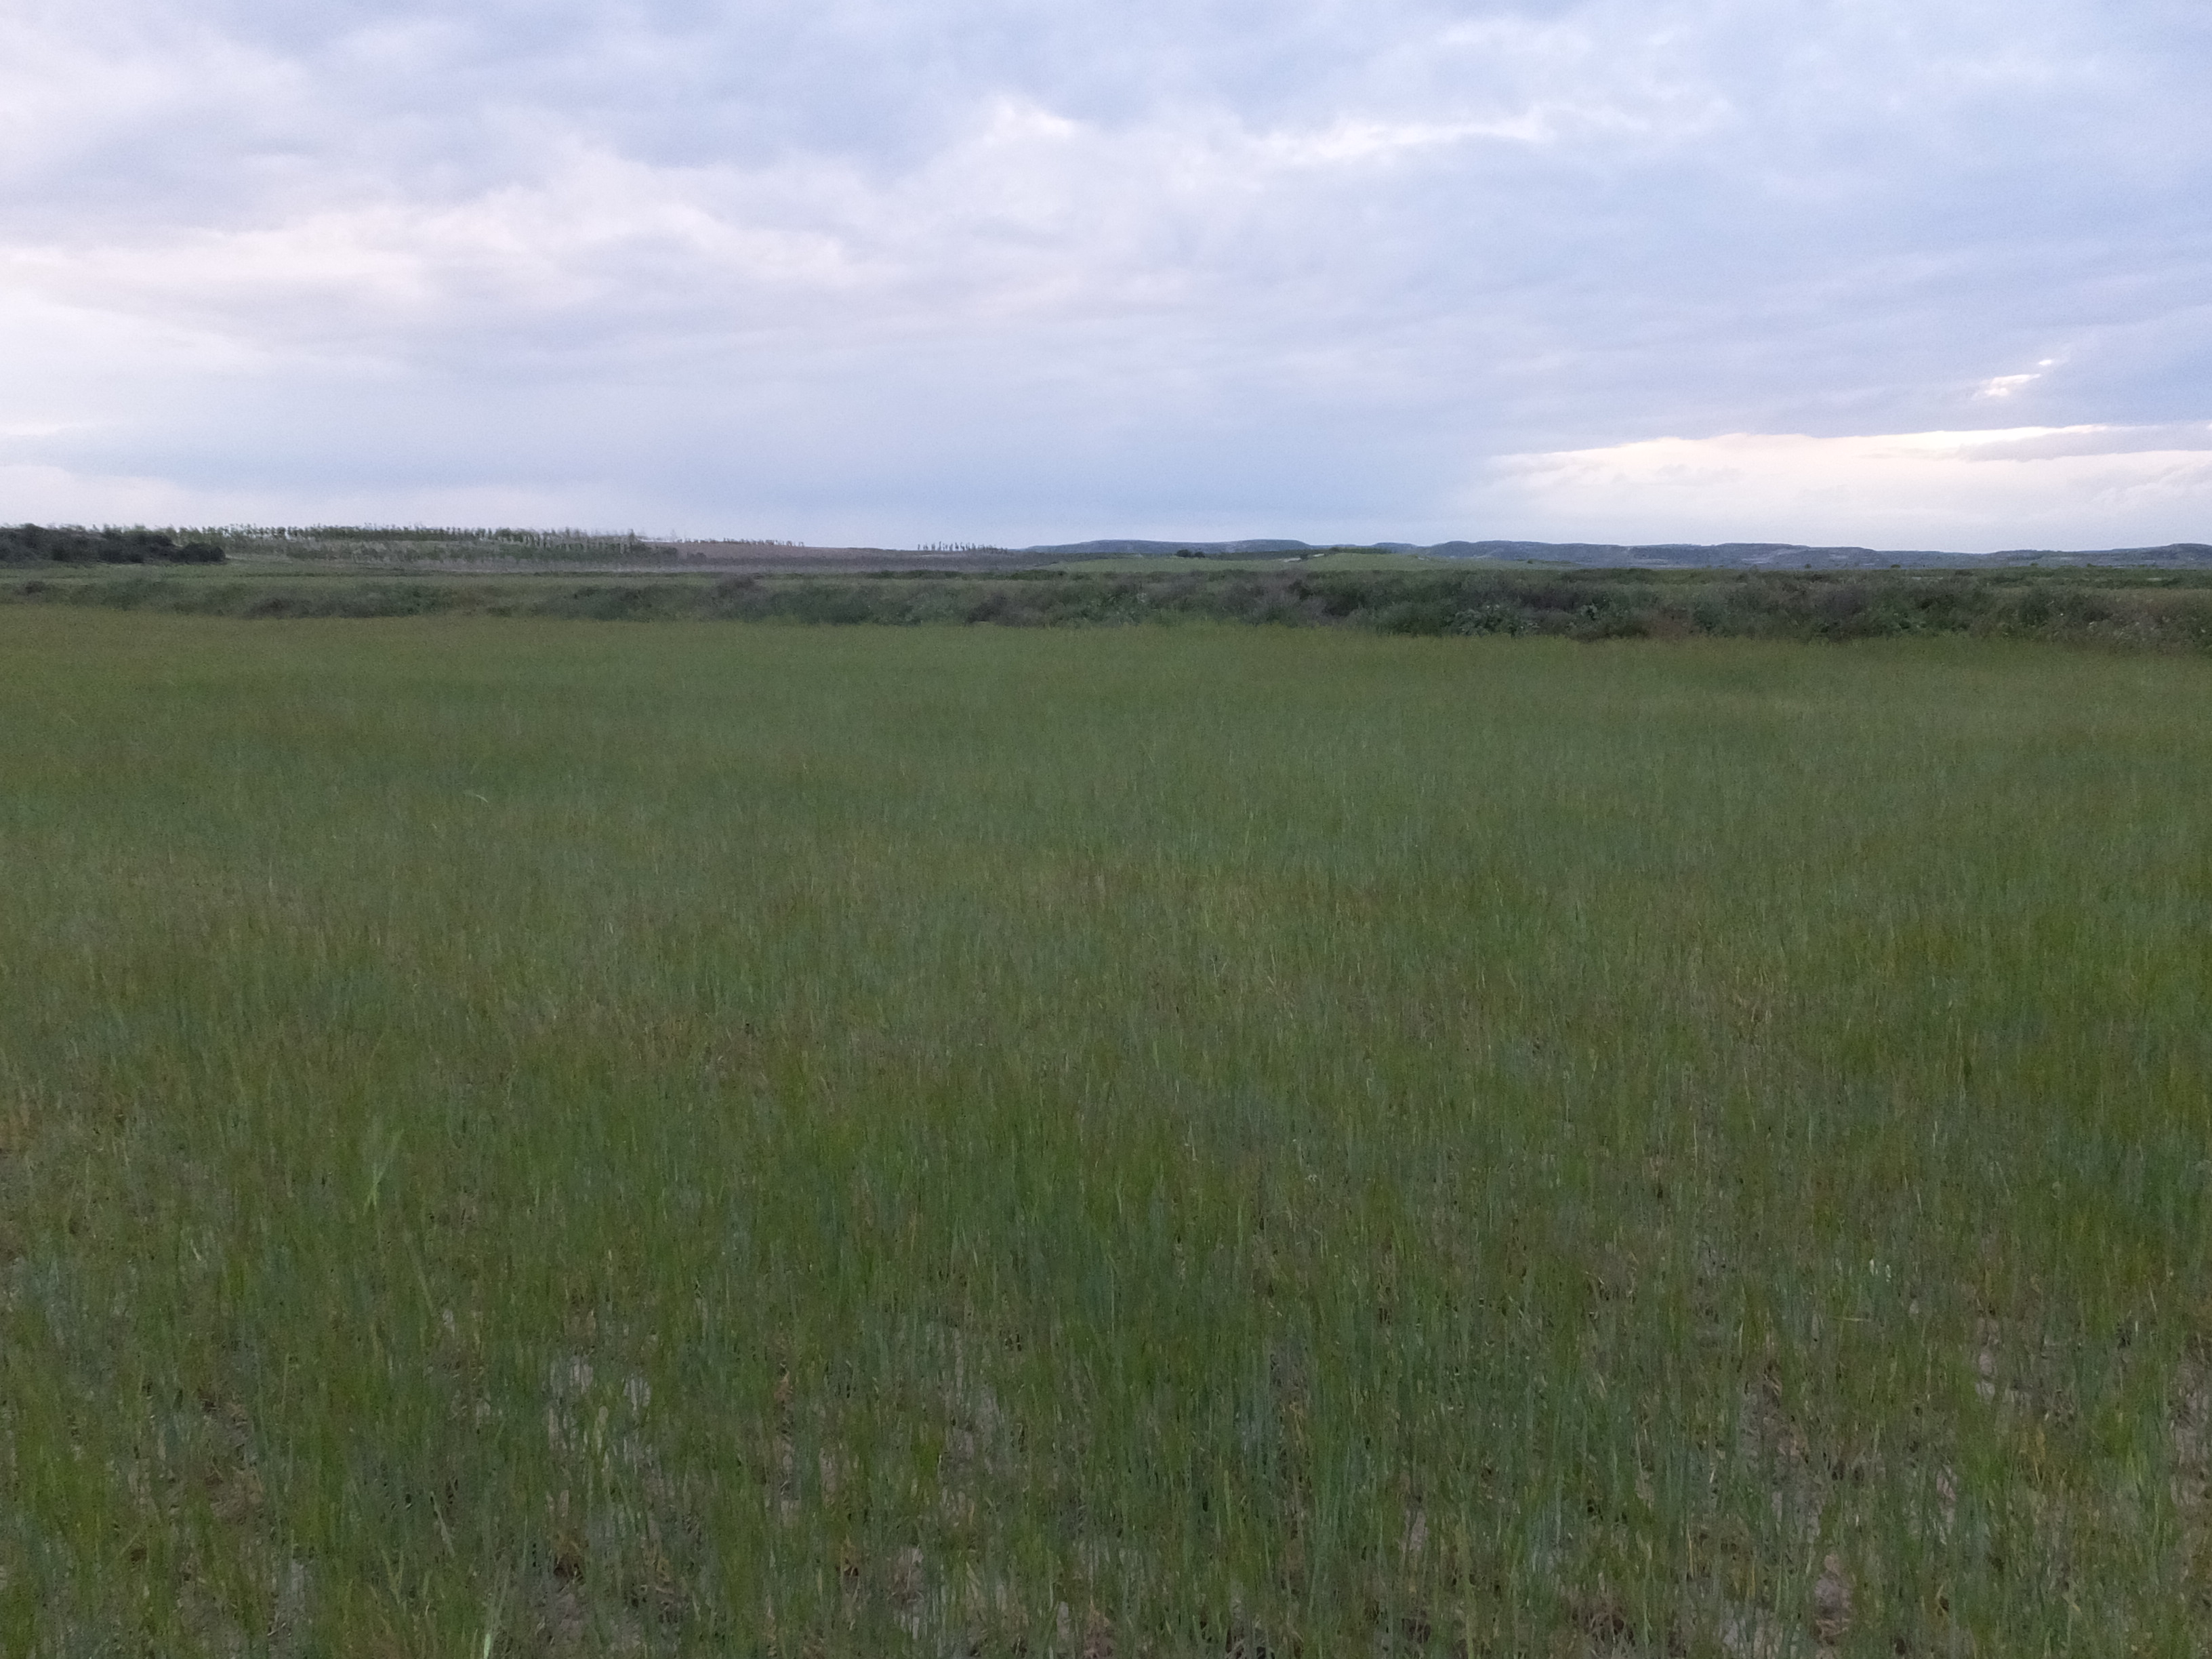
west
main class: Cropland
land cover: Barley
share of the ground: > 75 %
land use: Agriculture (excluding fallow land and kitchen gardens)
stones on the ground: < 10 %
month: April
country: ES
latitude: 41.6324
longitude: -0.1600
